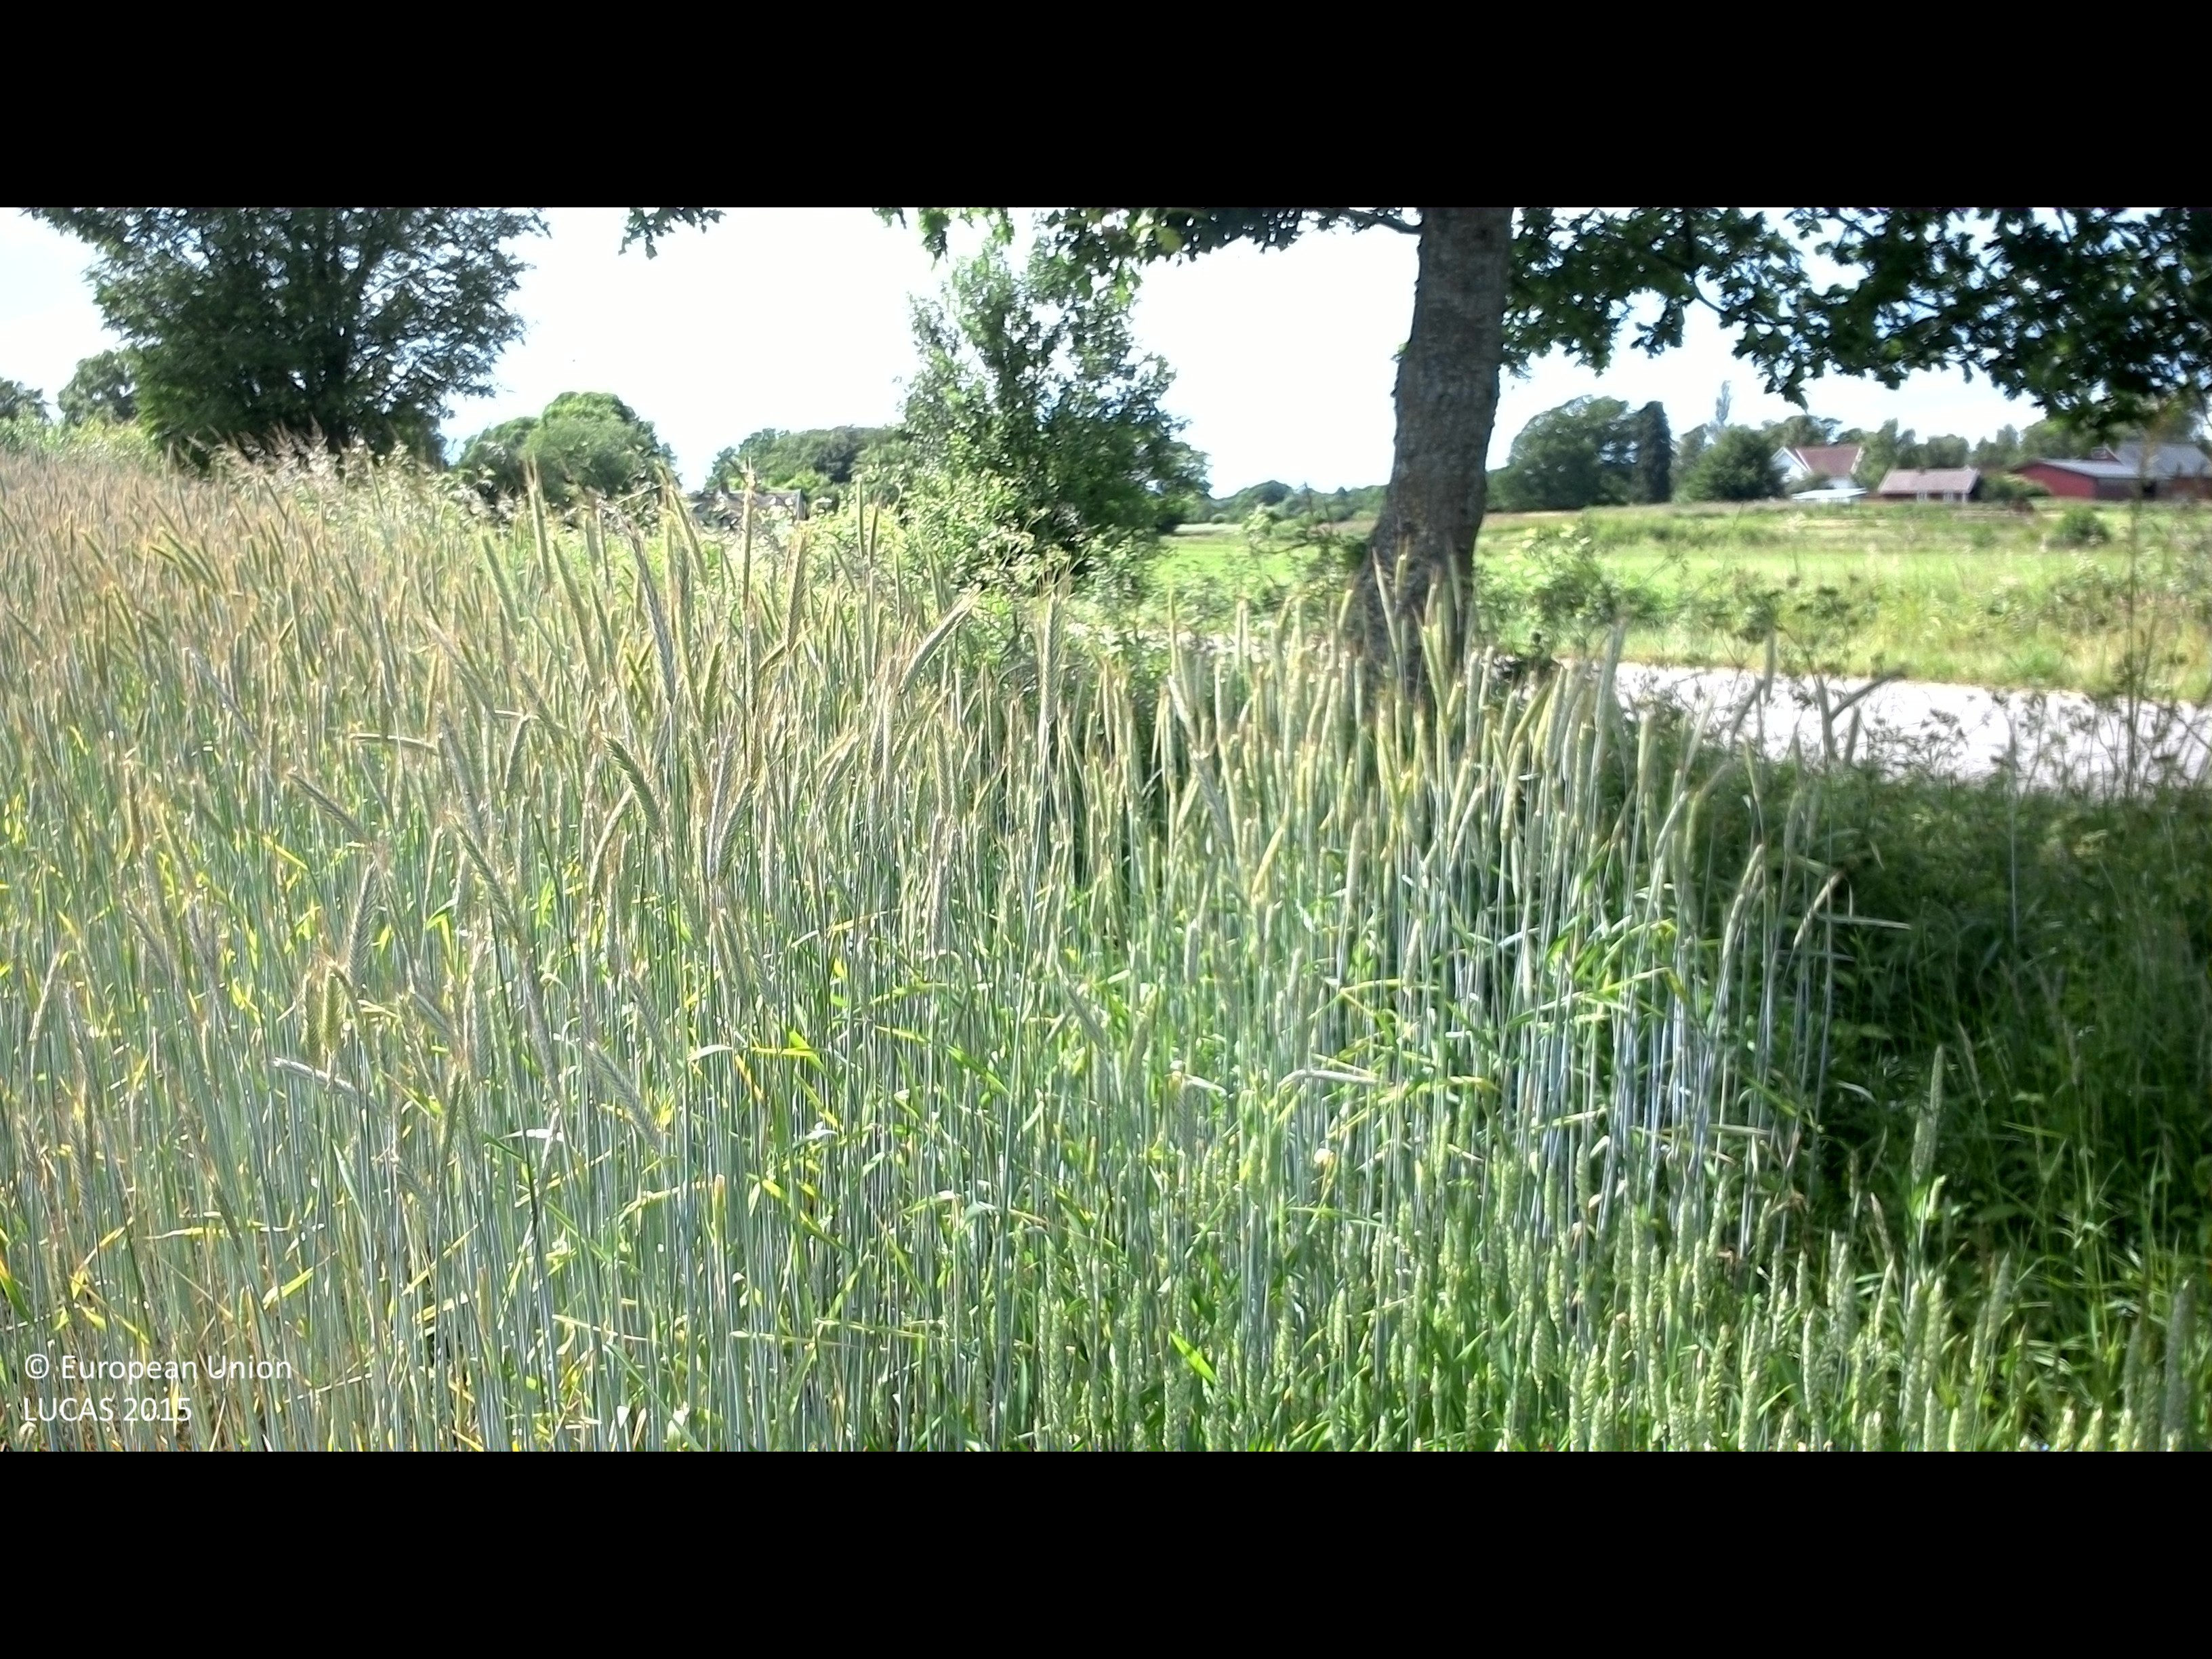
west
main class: Cropland
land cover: Common wheat
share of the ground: > 75 %
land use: Agriculture (excluding fallow land and kitchen gardens)
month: June
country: SE
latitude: 56.4045
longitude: 16.0774
